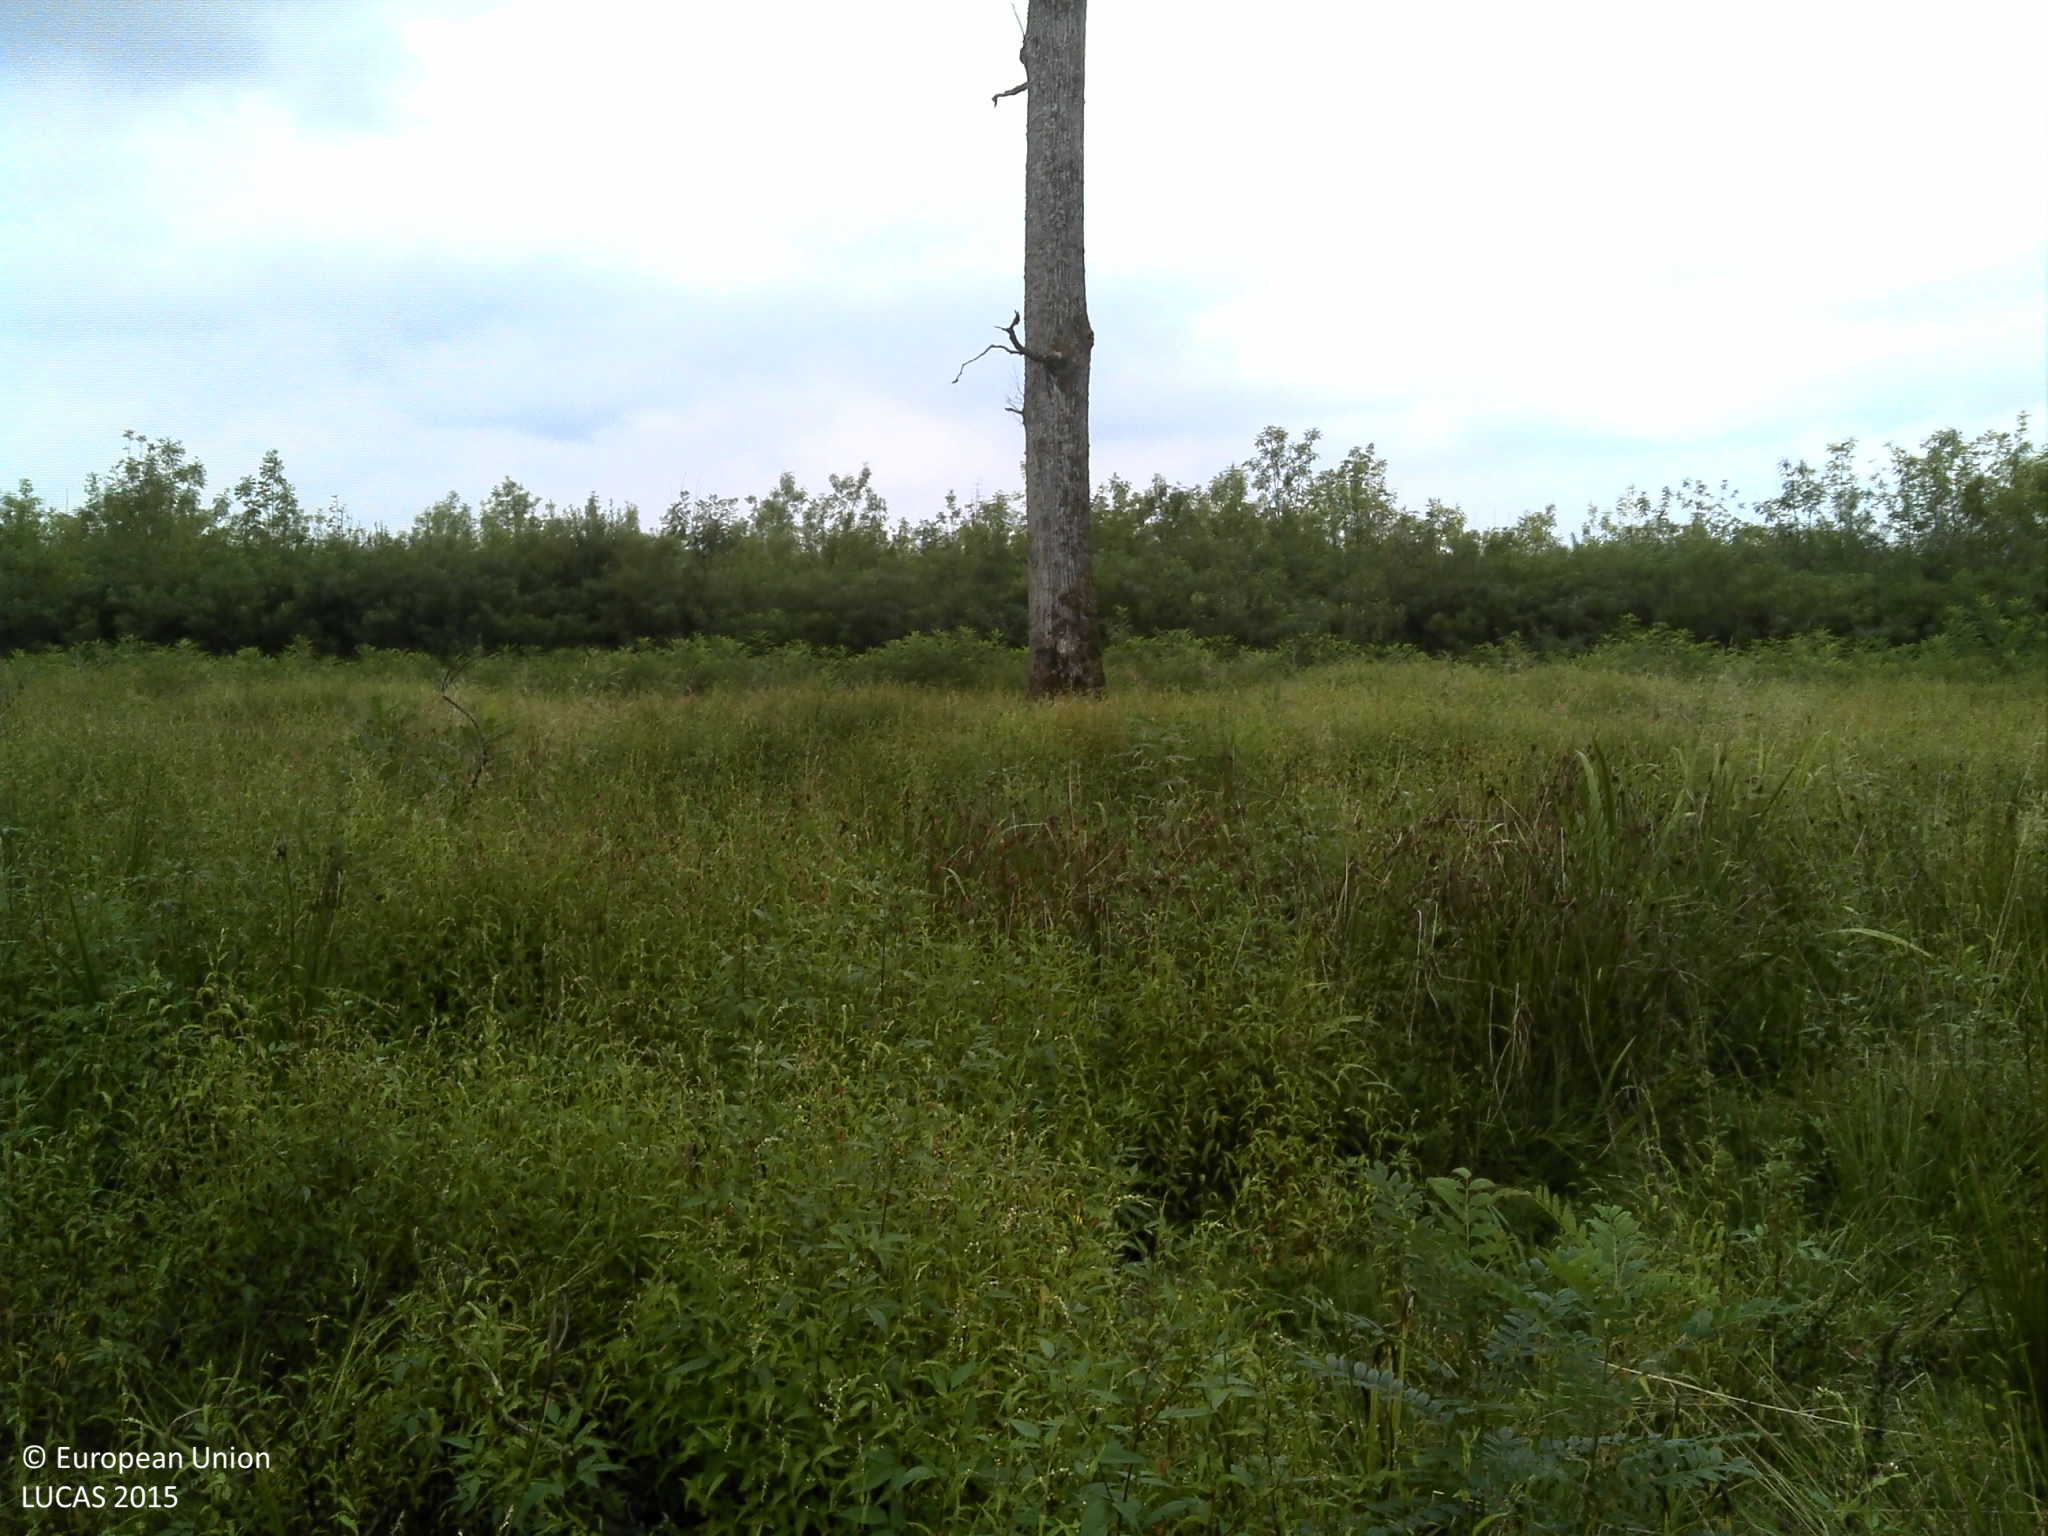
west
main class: Woodland
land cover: Broadleaved woodland
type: acidophilous oak and oak-birch forest
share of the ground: 25 - 50 %
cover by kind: herbaceous plants 60 %, broadleaved forest trees 40 %
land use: Forestry
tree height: > 5 m
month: August
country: HR
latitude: 45.2887
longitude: 16.7429
